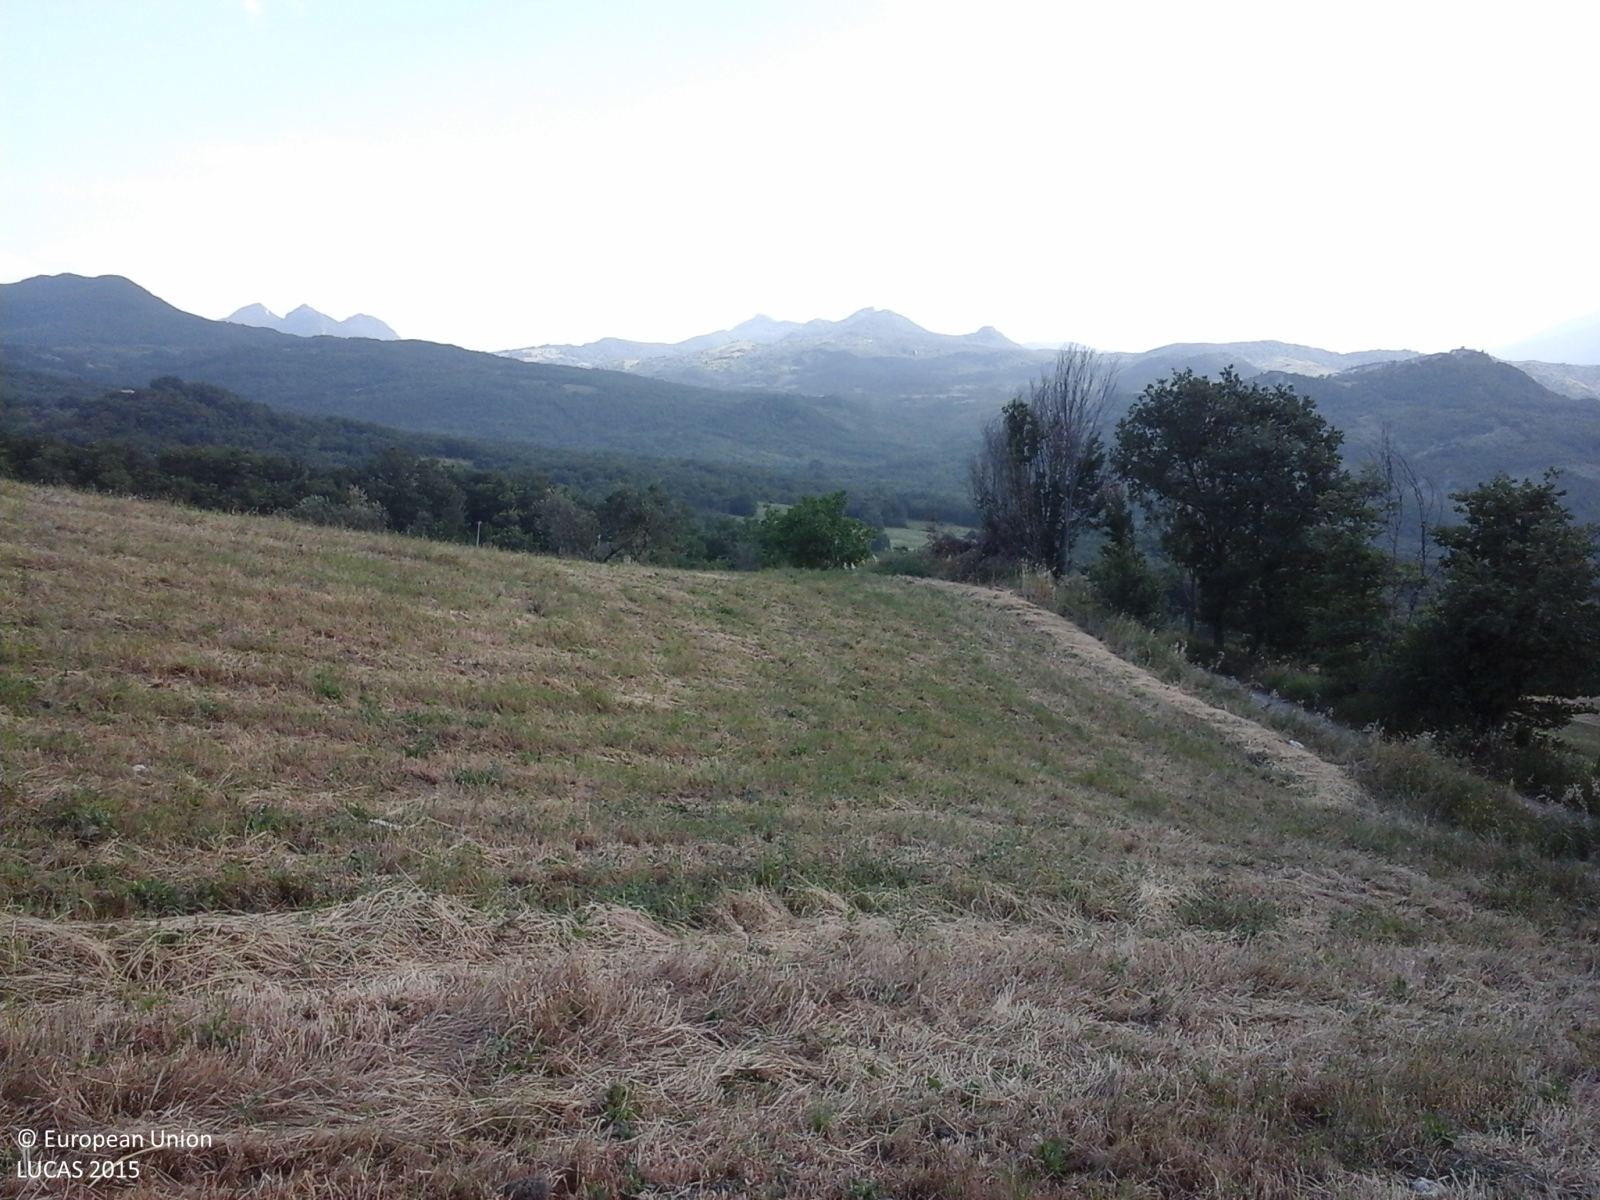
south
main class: Cropland
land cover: Other leguminous and mixtures for fodder
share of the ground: > 75 %
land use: Agriculture (excluding fallow land and kitchen gardens)
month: June
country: IT
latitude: 42.0233
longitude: 14.2253
